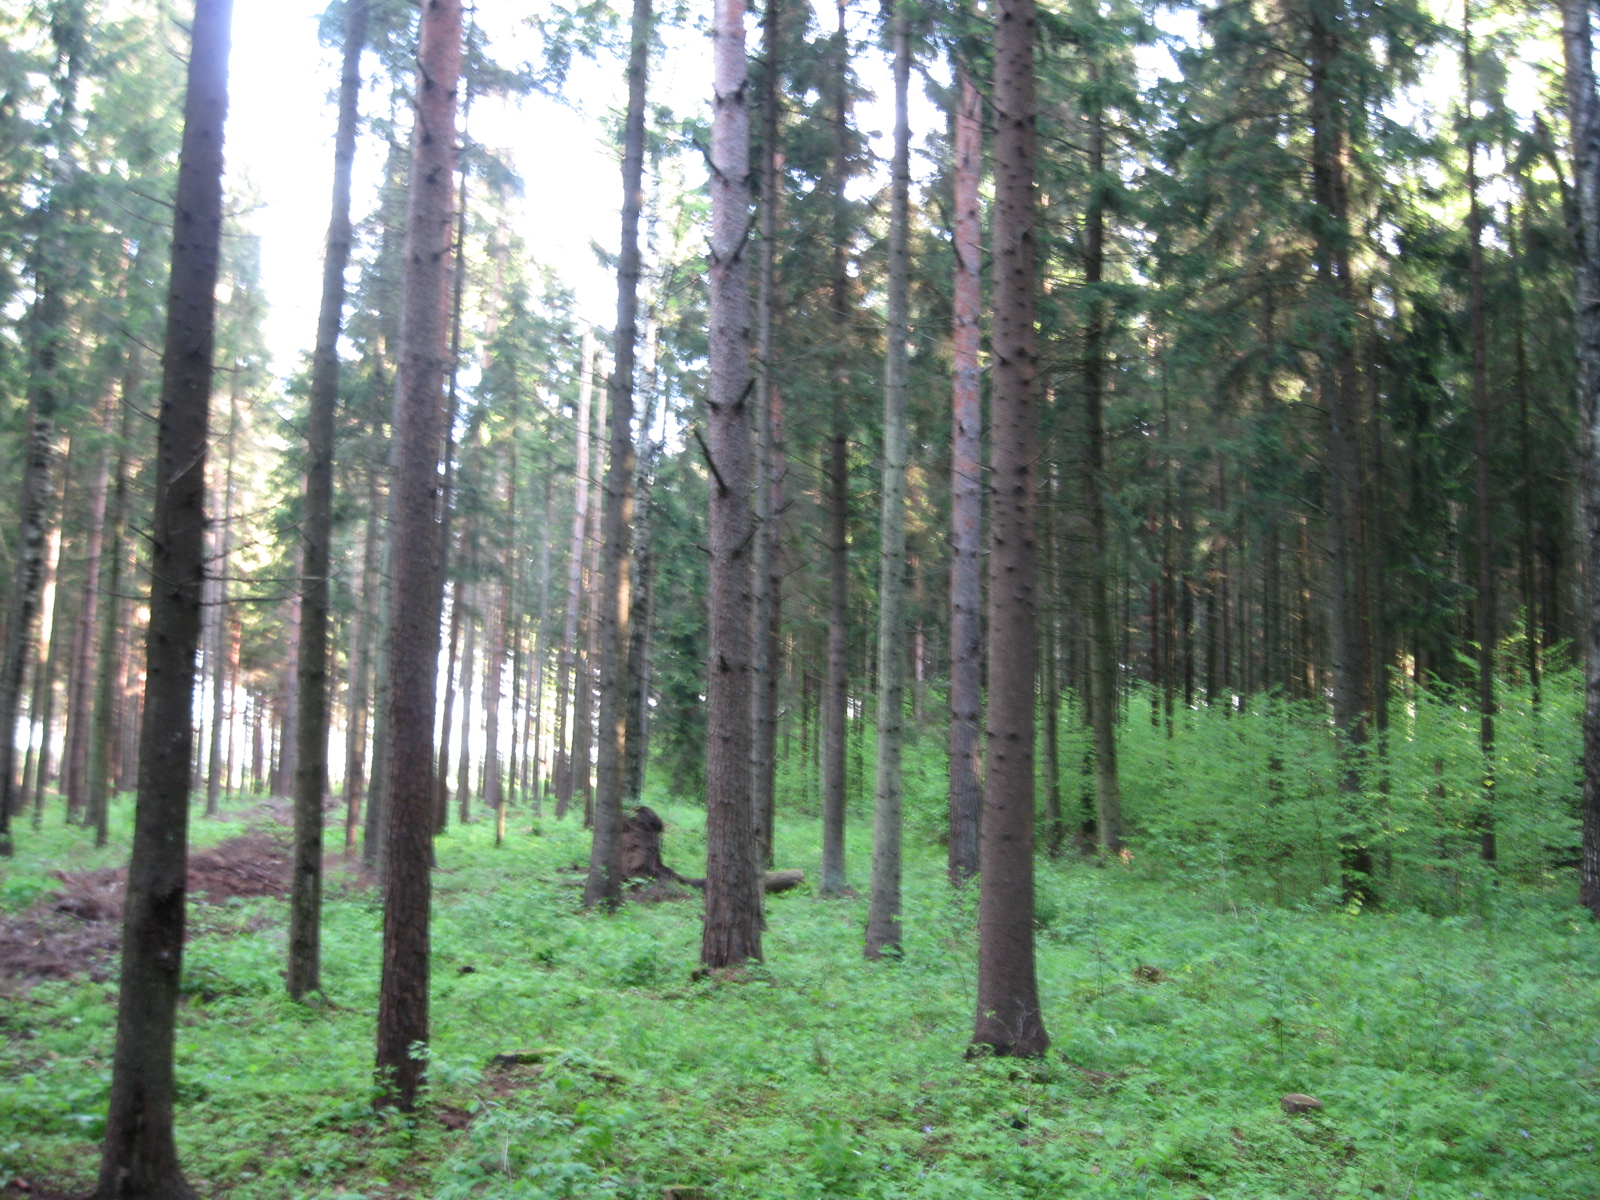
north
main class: Woodland
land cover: Spruce dominated coniferous woodland
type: hemiboreal forest and nemoral coniferous forest and mixed broadleaved-coniferous forest
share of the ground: > 75 %
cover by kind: coniferous forest trees 80 %, herbaceous plants 10 %, broadleaved forest trees 5 %, shrubs 5 %
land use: Forestry
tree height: > 5 m
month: May
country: LT
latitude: 56.3280
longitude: 24.0103
